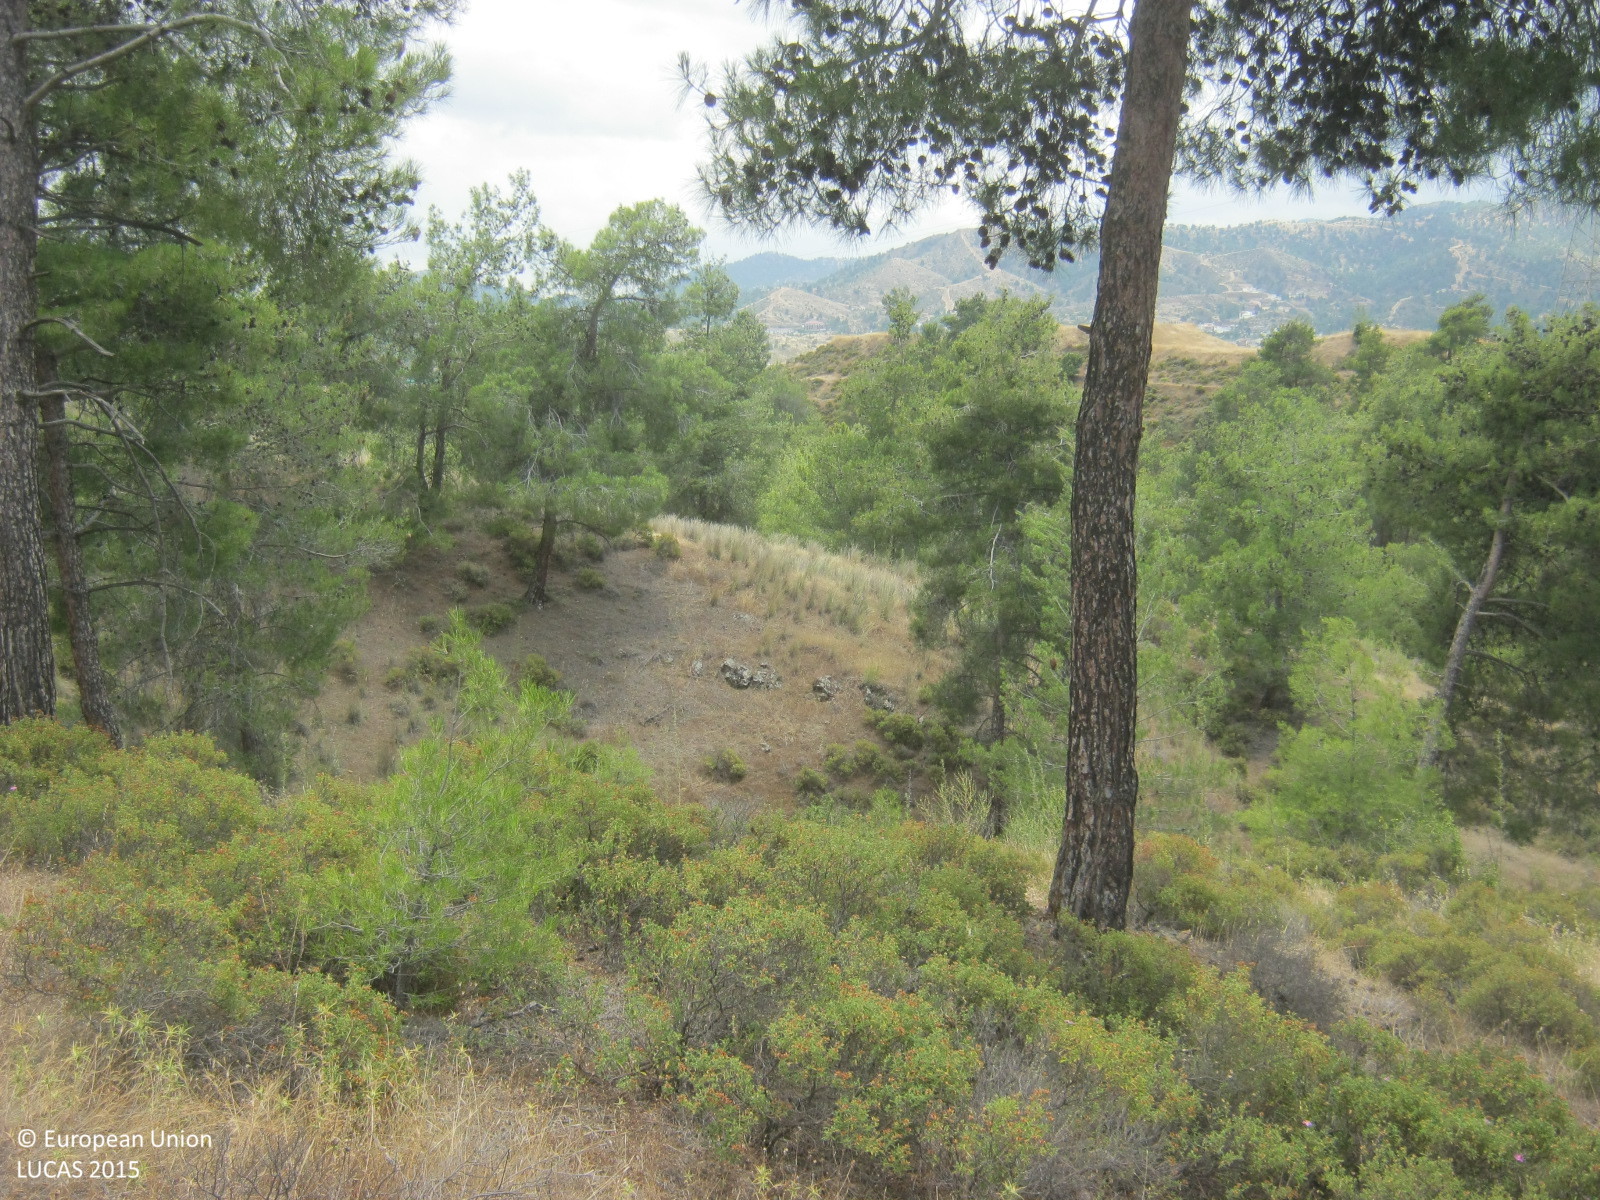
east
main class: Woodland
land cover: Pine dominated coniferous woodland
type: coniferous forest of the mediterranean region
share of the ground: 10 - 25 %
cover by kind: shrubs 40 %, herbaceous plants 30 %, coniferous forest trees 25 %, unconsolidated bare surface 5 %
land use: Forestry
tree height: > 5 m
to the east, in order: Pine dominated coniferous woodland; Rivers and streams; Pine dominated coniferous woodland; Tracks; Pine dominated coniferous woodland; Electric lines; Pine dominated coniferous woodland; Rivers and streams; Pine dominated coniferous woodland
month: June
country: CY
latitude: 35.0505
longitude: 32.8762
